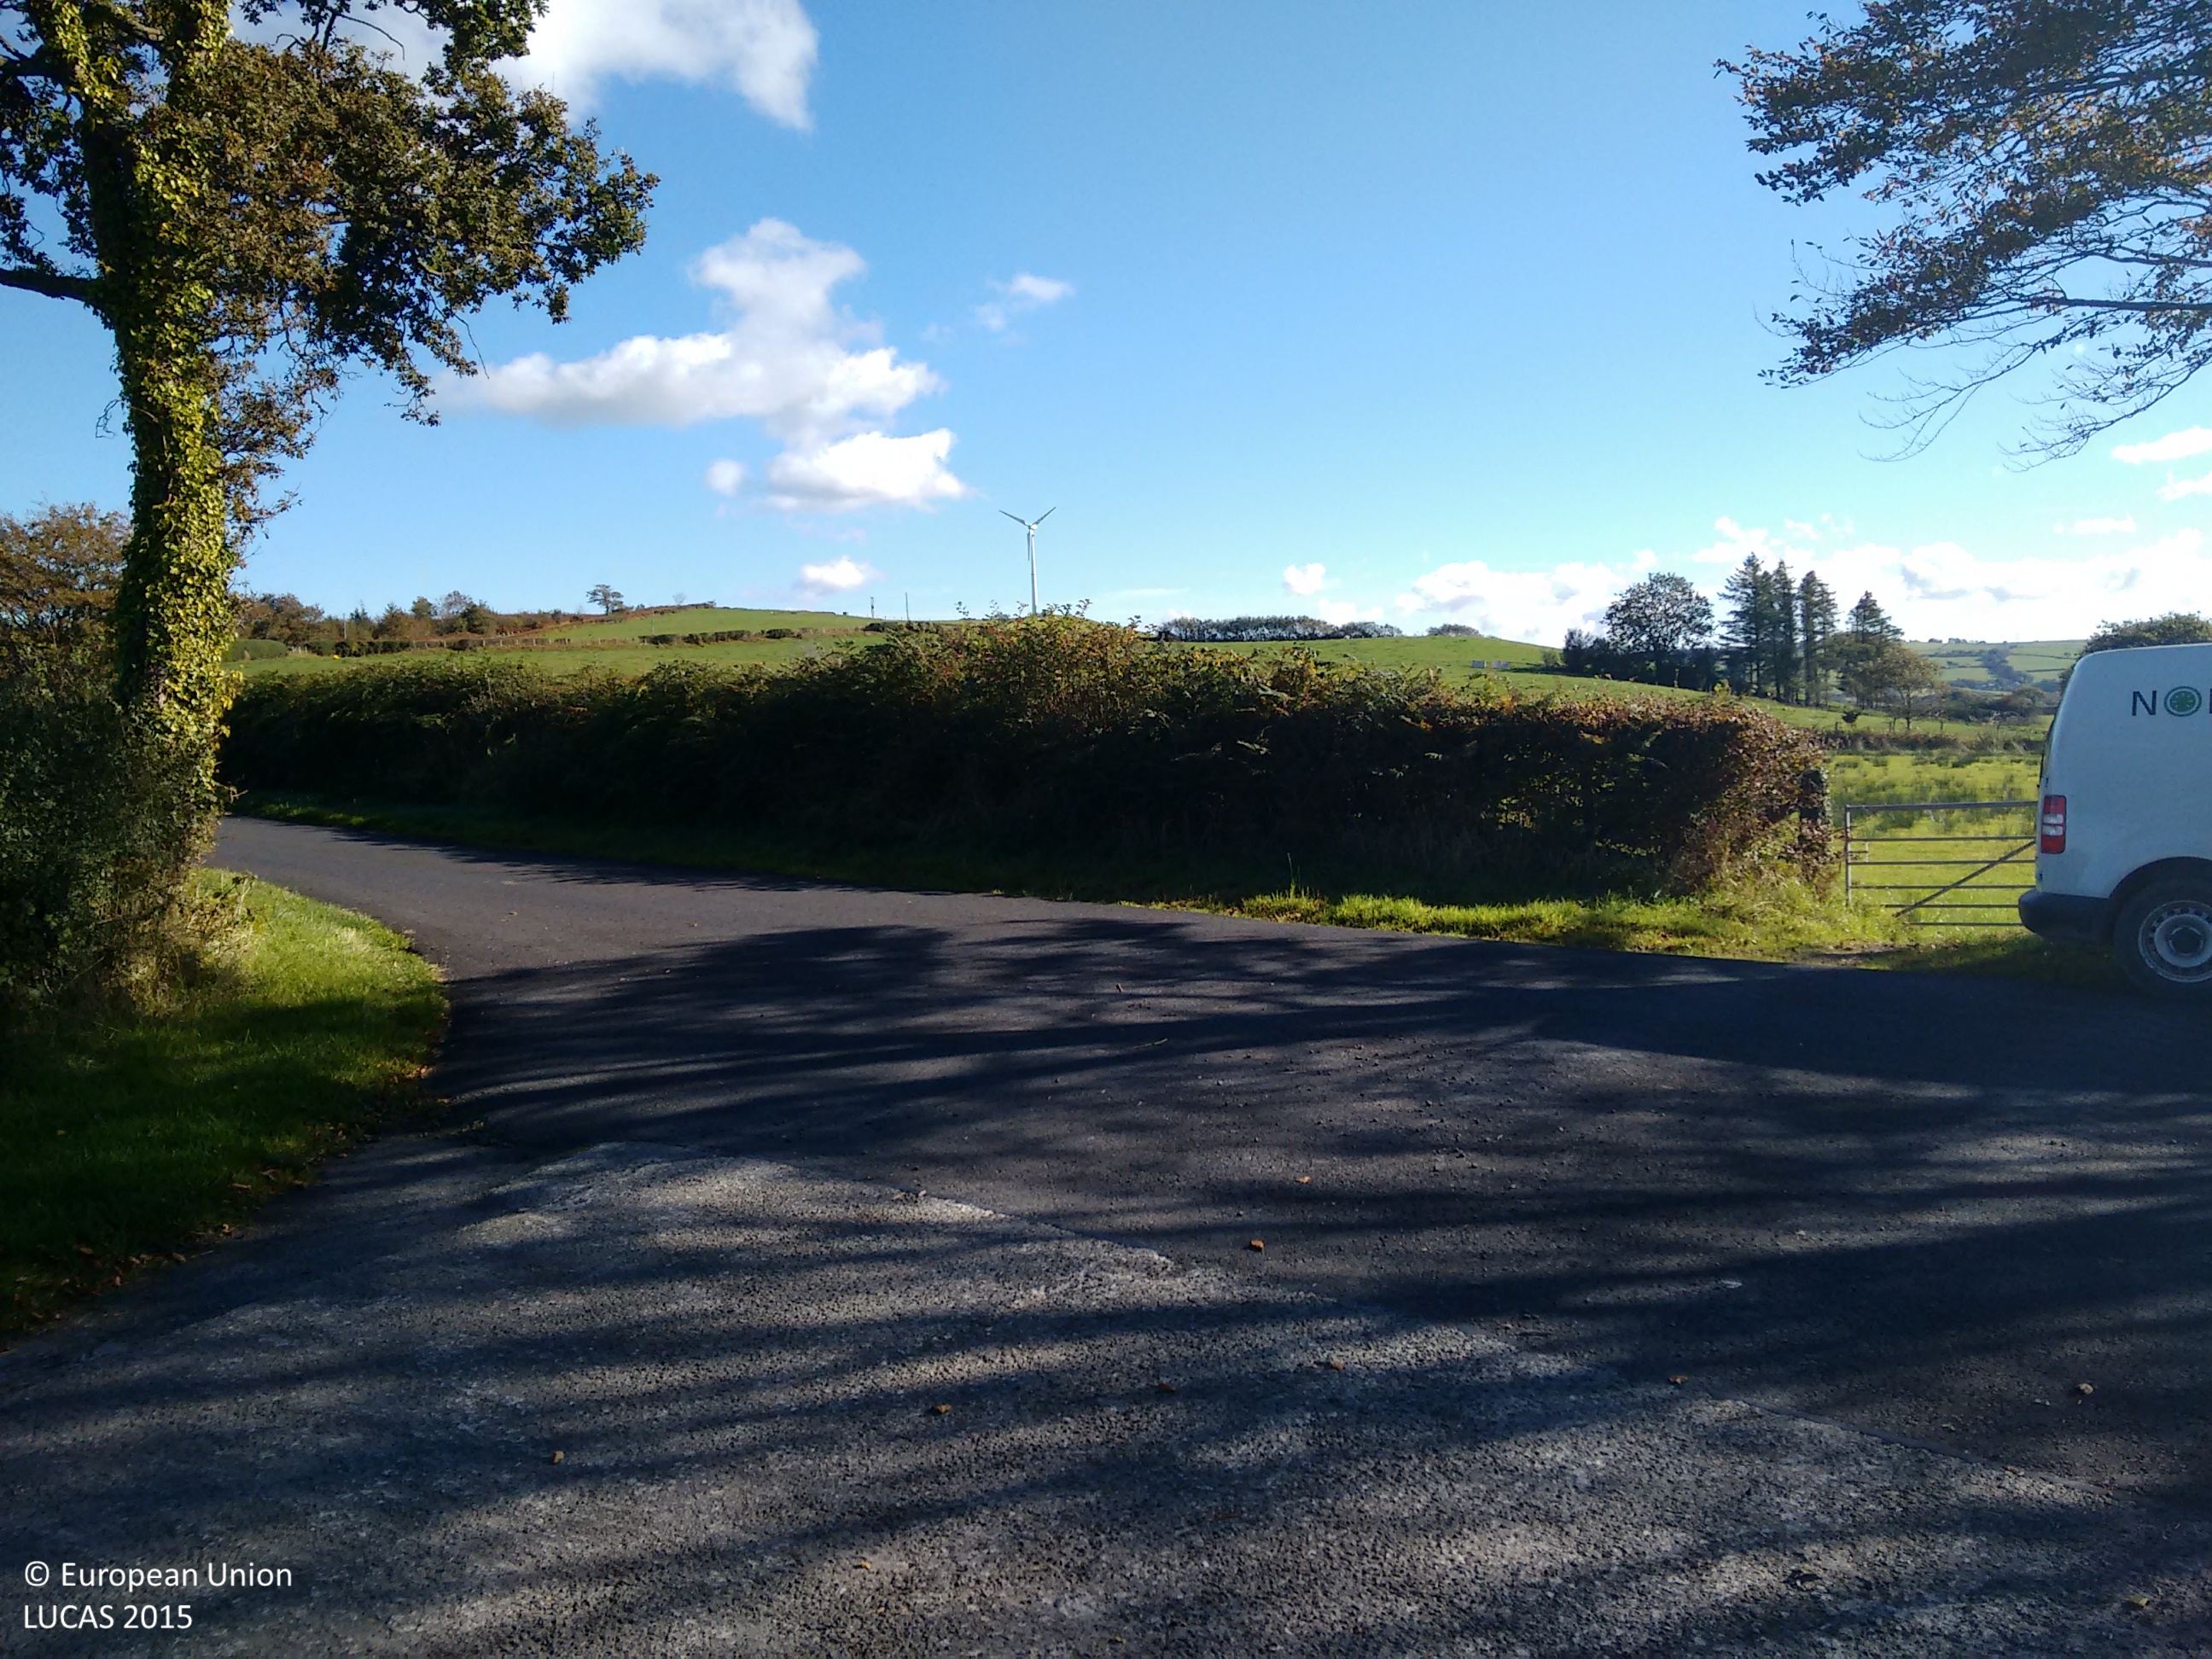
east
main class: Grassland
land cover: Grassland without tree/shrub cover
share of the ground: > 75 %
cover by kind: herbaceous plants 100 %
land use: Agriculture (excluding fallow land and kitchen gardens)
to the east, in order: Grassland without tree/shrub cover; Fences; Managed hedges; Grass margins; Paved roads, cycling and walking lanes; Grass margins; Single bushes/trees; Managed hedges; Fences; Grassland without tree/shrub cover; Fences; Ditches and canals; Fences; Grassland without tree/shrub cover
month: October
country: GB
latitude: 52.3252
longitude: -4.0192
